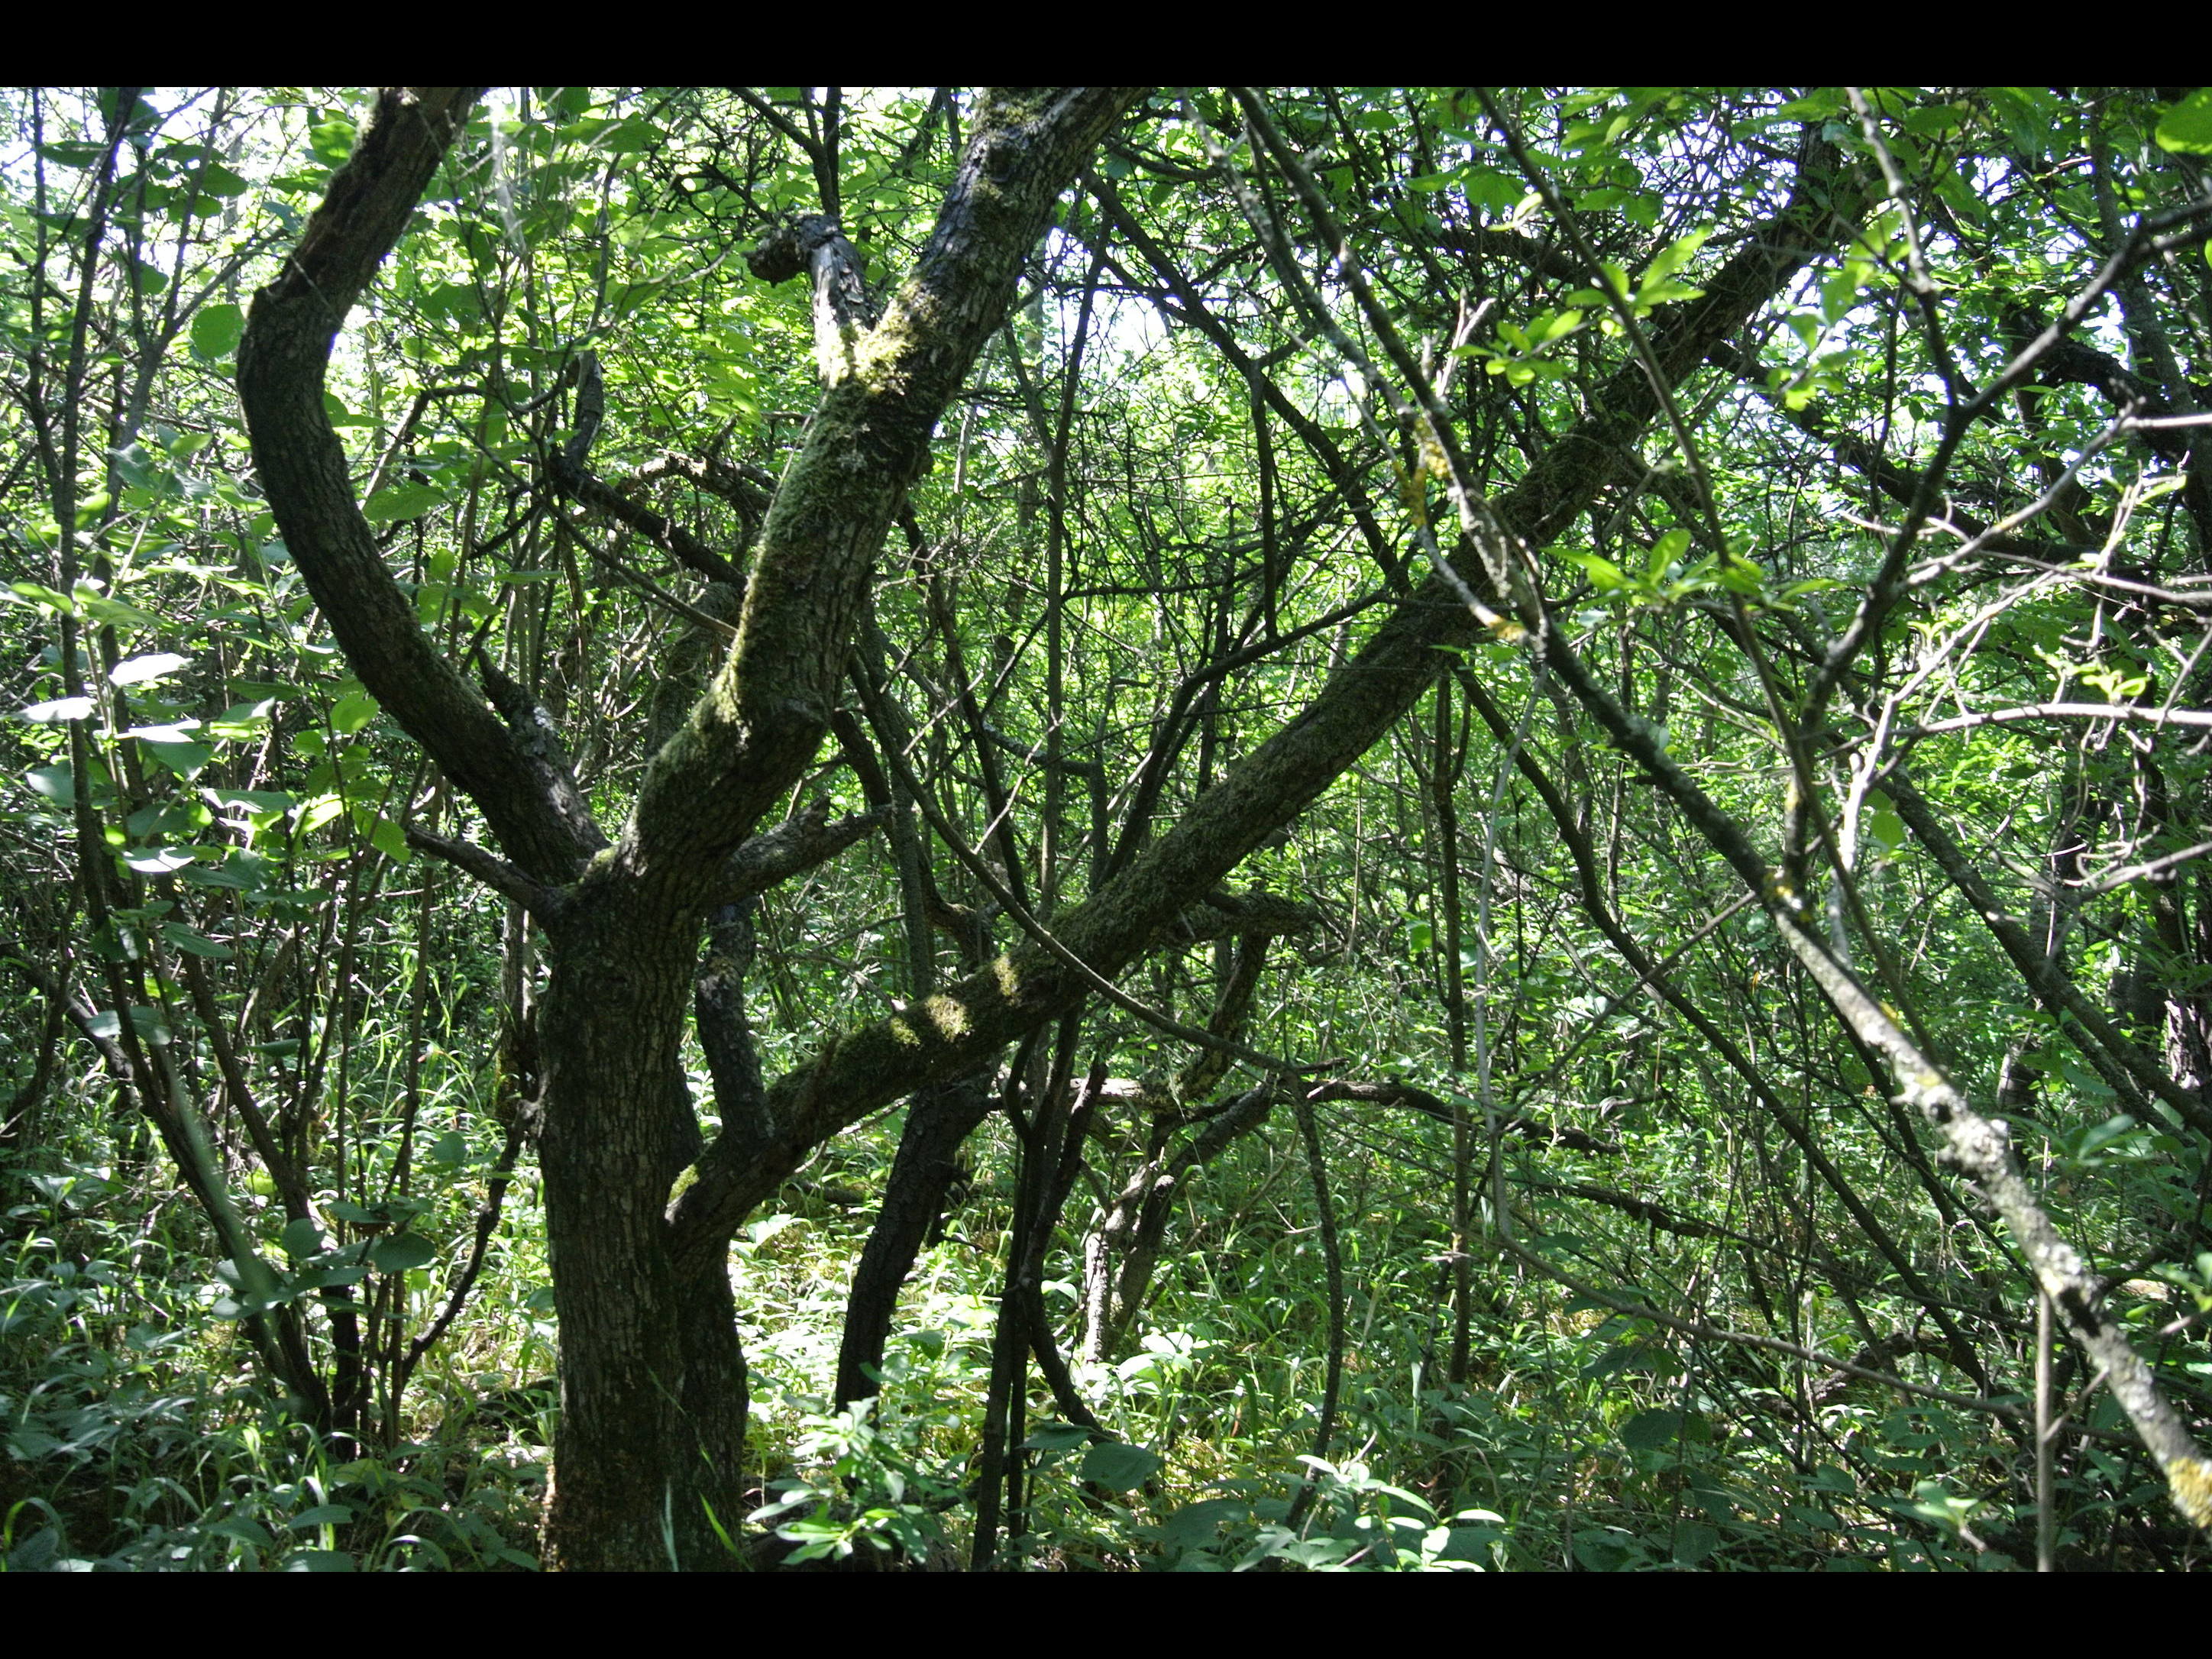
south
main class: Woodland
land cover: Broadleaved woodland
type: mesophytic deciduous forest
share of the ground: > 75 %
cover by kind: broadleaved forest trees 90 %, herbaceous plants 10 %
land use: Forestry
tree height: > 5 m
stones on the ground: 10 - 25 %
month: June
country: AT
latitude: 47.8177
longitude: 16.4552
